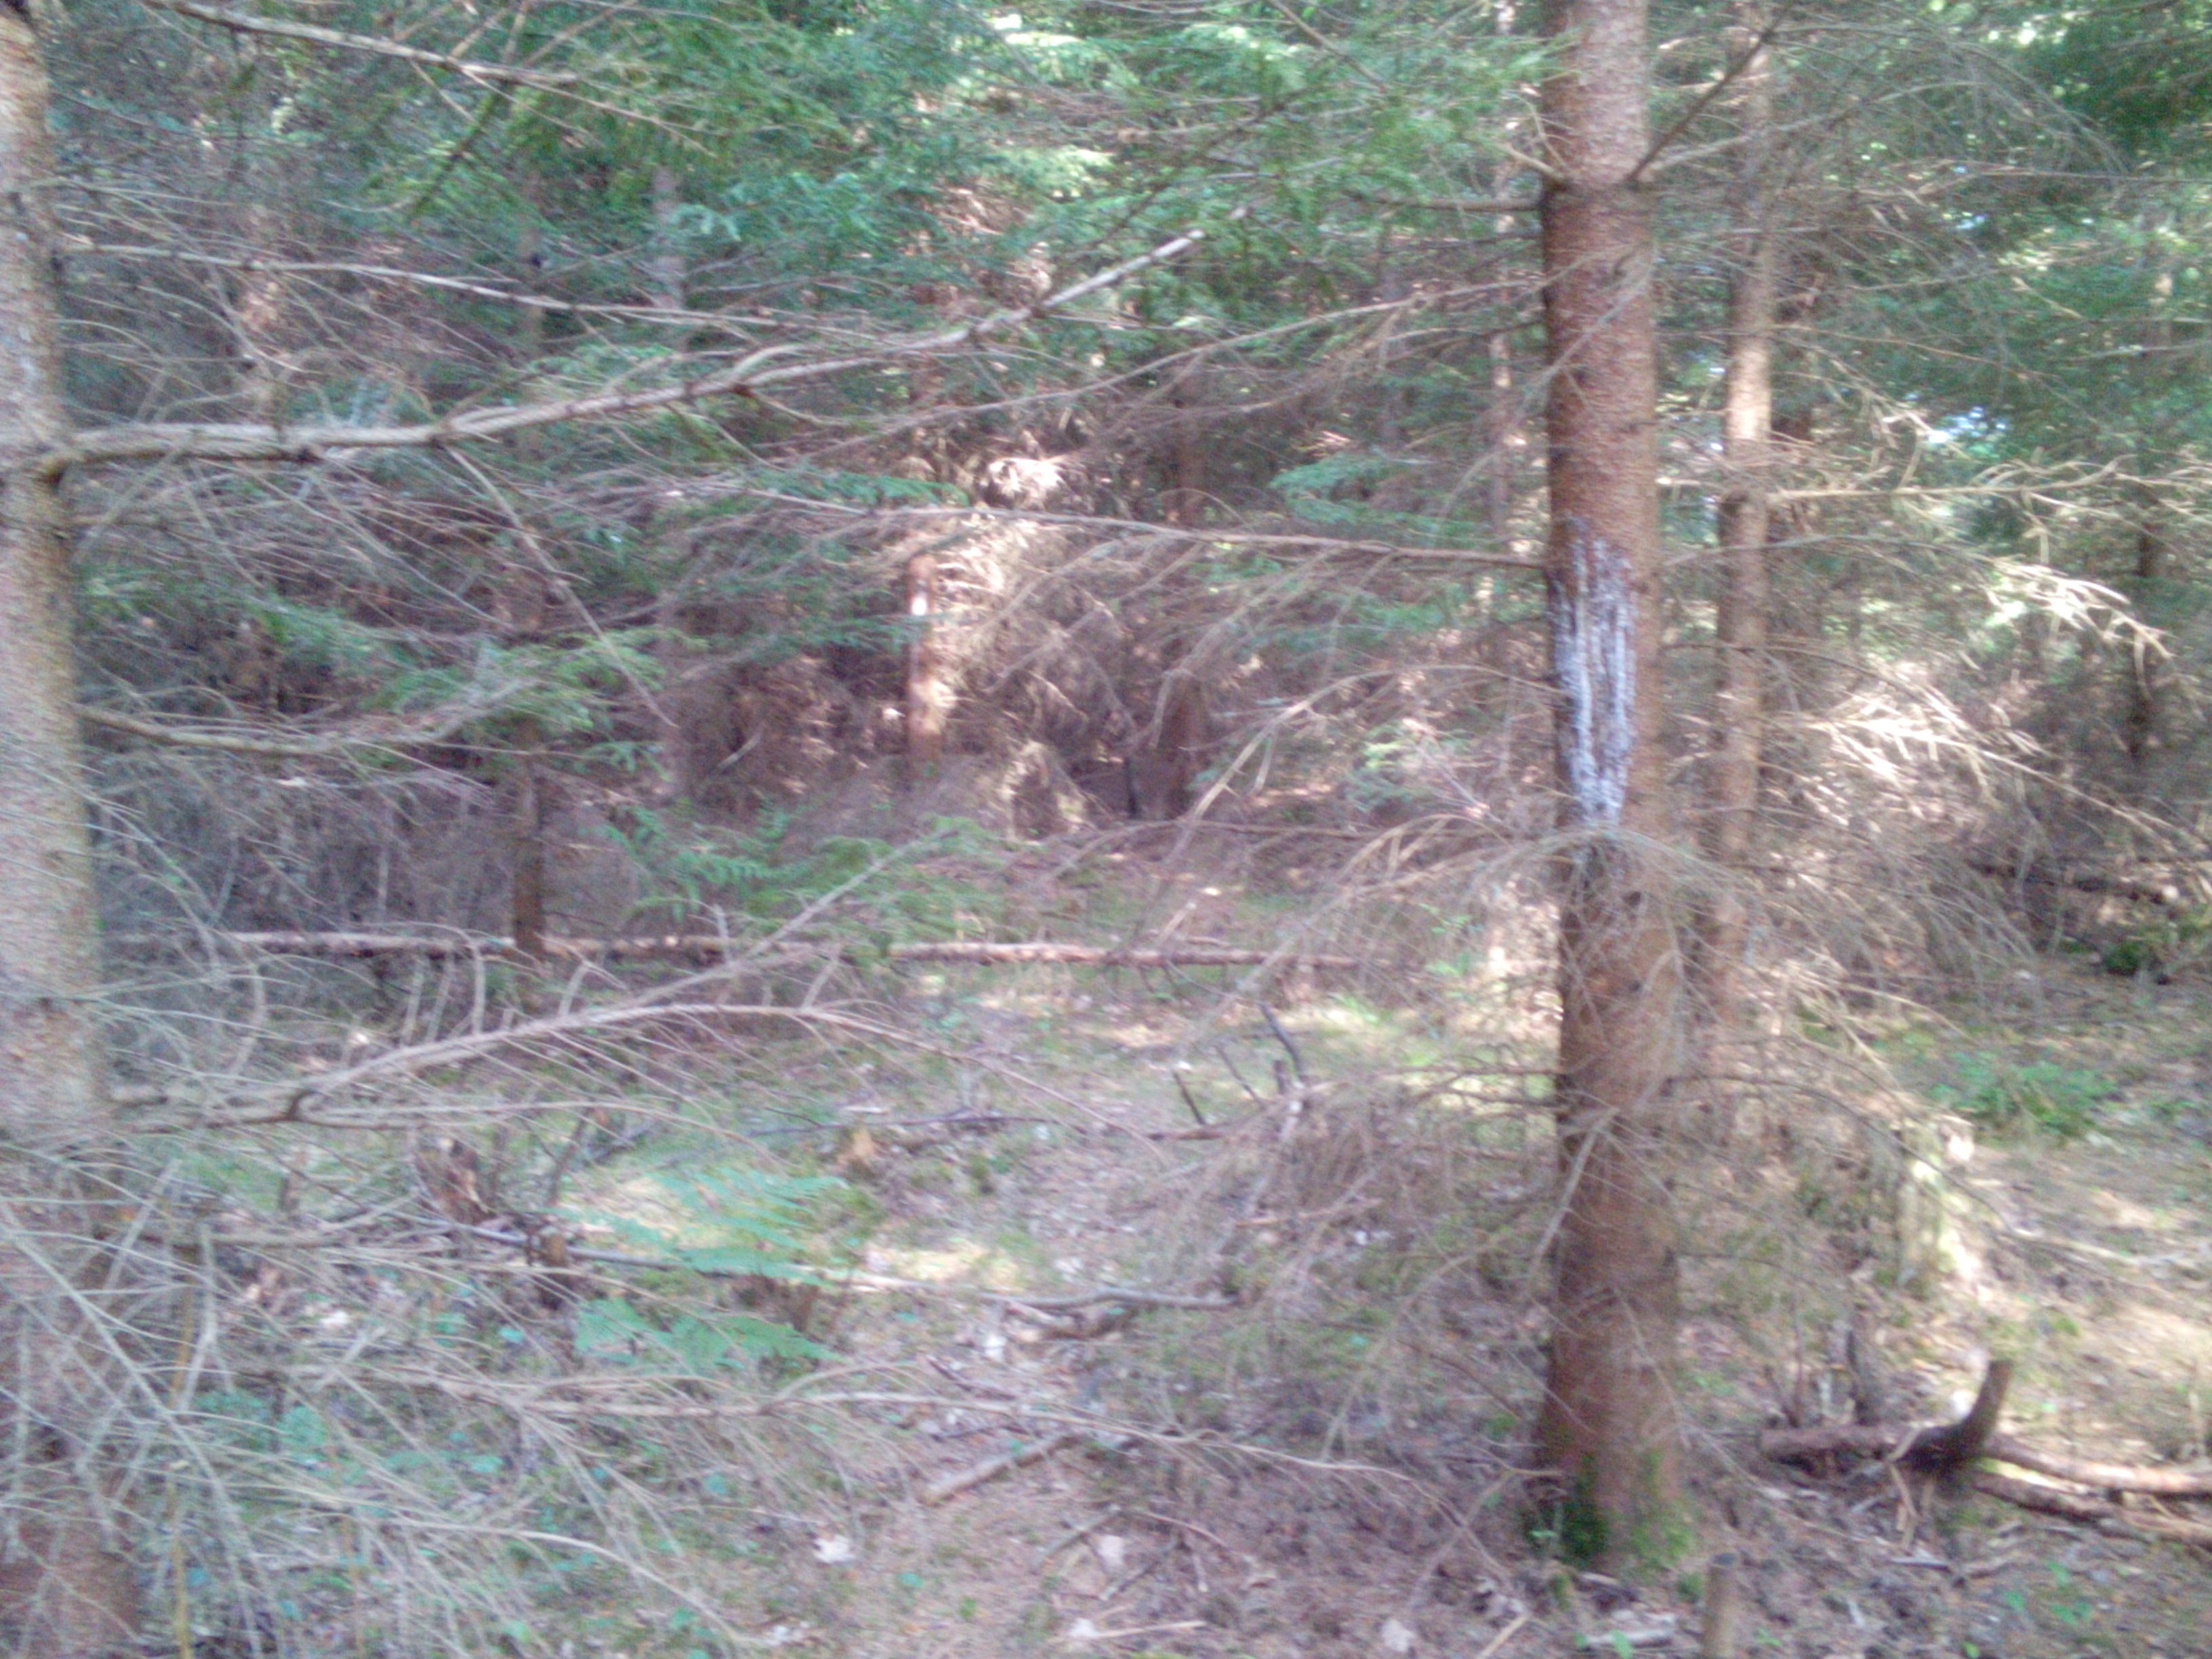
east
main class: Woodland
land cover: Spruce dominated mixed woodland
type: hemiboreal forest and nemoral coniferous forest and mixed broadleaved-coniferous forest
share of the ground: > 75 %
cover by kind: coniferous forest trees 70 %, broadleaved forest trees 30 %
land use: Forestry
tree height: > 5 m
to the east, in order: Spruce dominated mixed woodland; Broadleaved woodland; Spruce dominated coniferous woodland
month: June
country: LV
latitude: 56.7123
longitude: 21.8248
